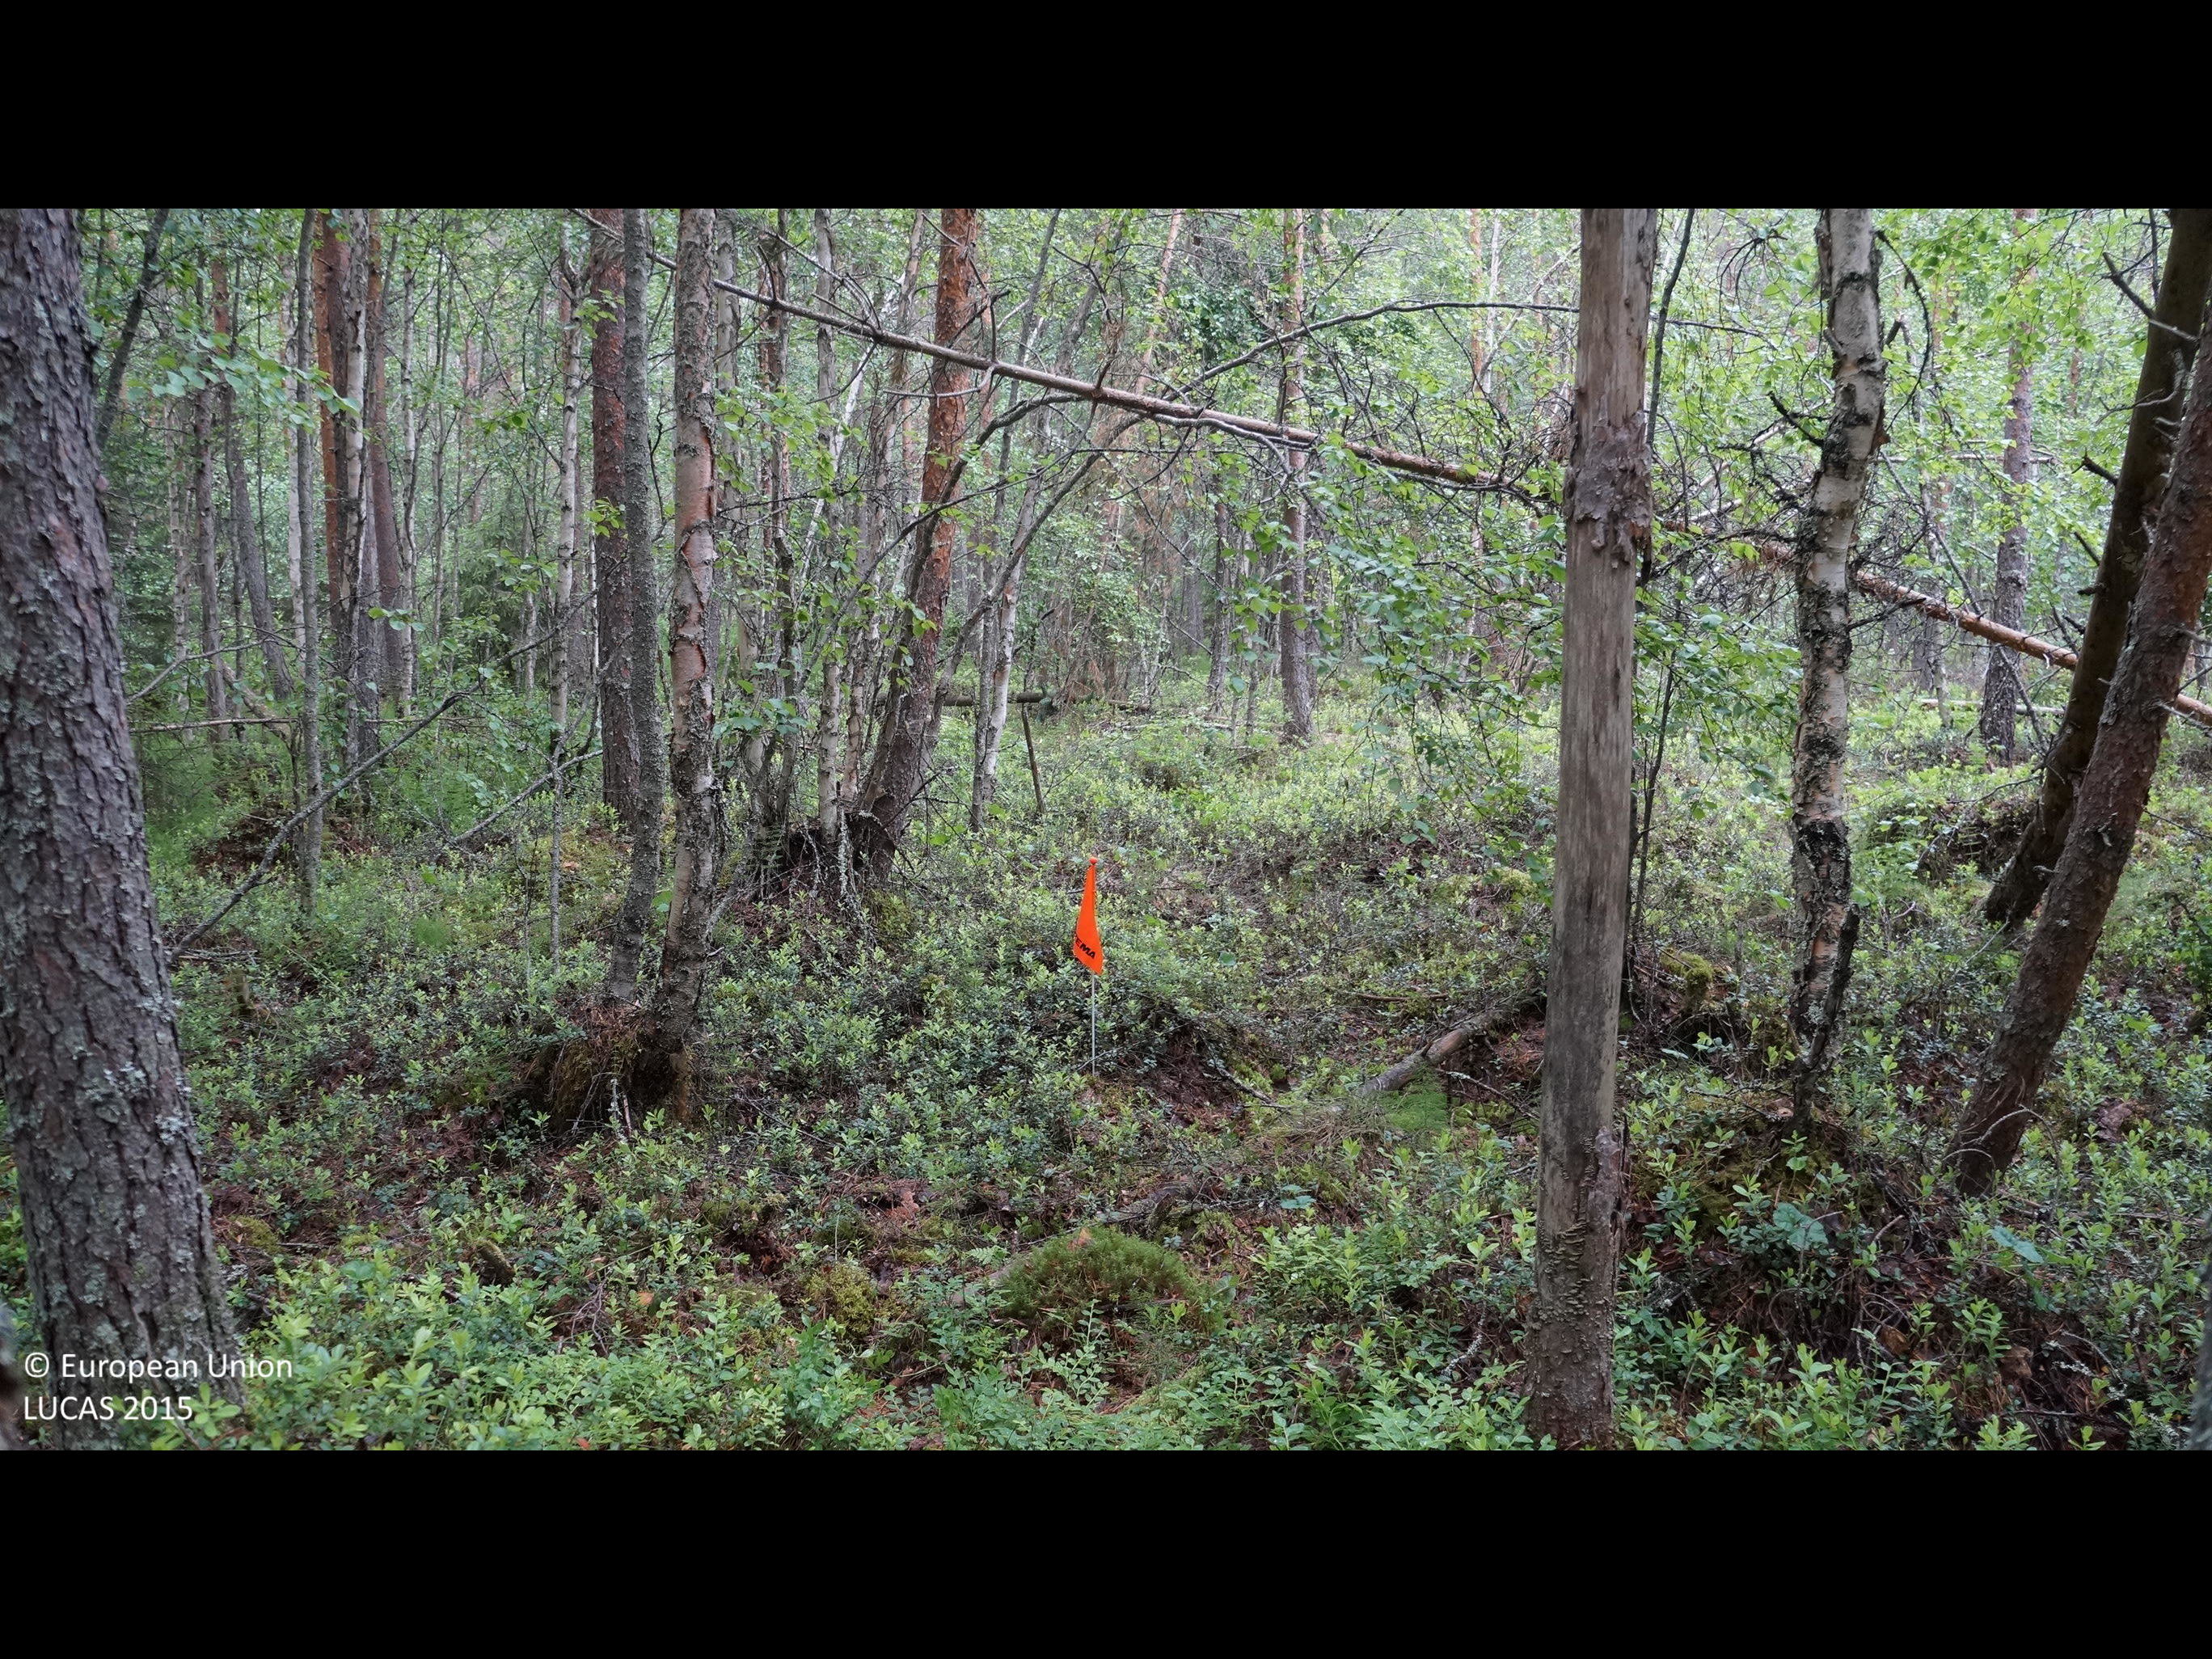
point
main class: Woodland
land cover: Pine dominated mixed woodland
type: boreal forest
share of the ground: > 75 %
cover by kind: coniferous forest trees 45 %, broadleaved forest trees 30 %, shrubs 15 %, lichens and mosses 10 %
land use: Forestry
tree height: > 5 m
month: June
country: FI
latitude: 64.3035
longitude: 24.6467
